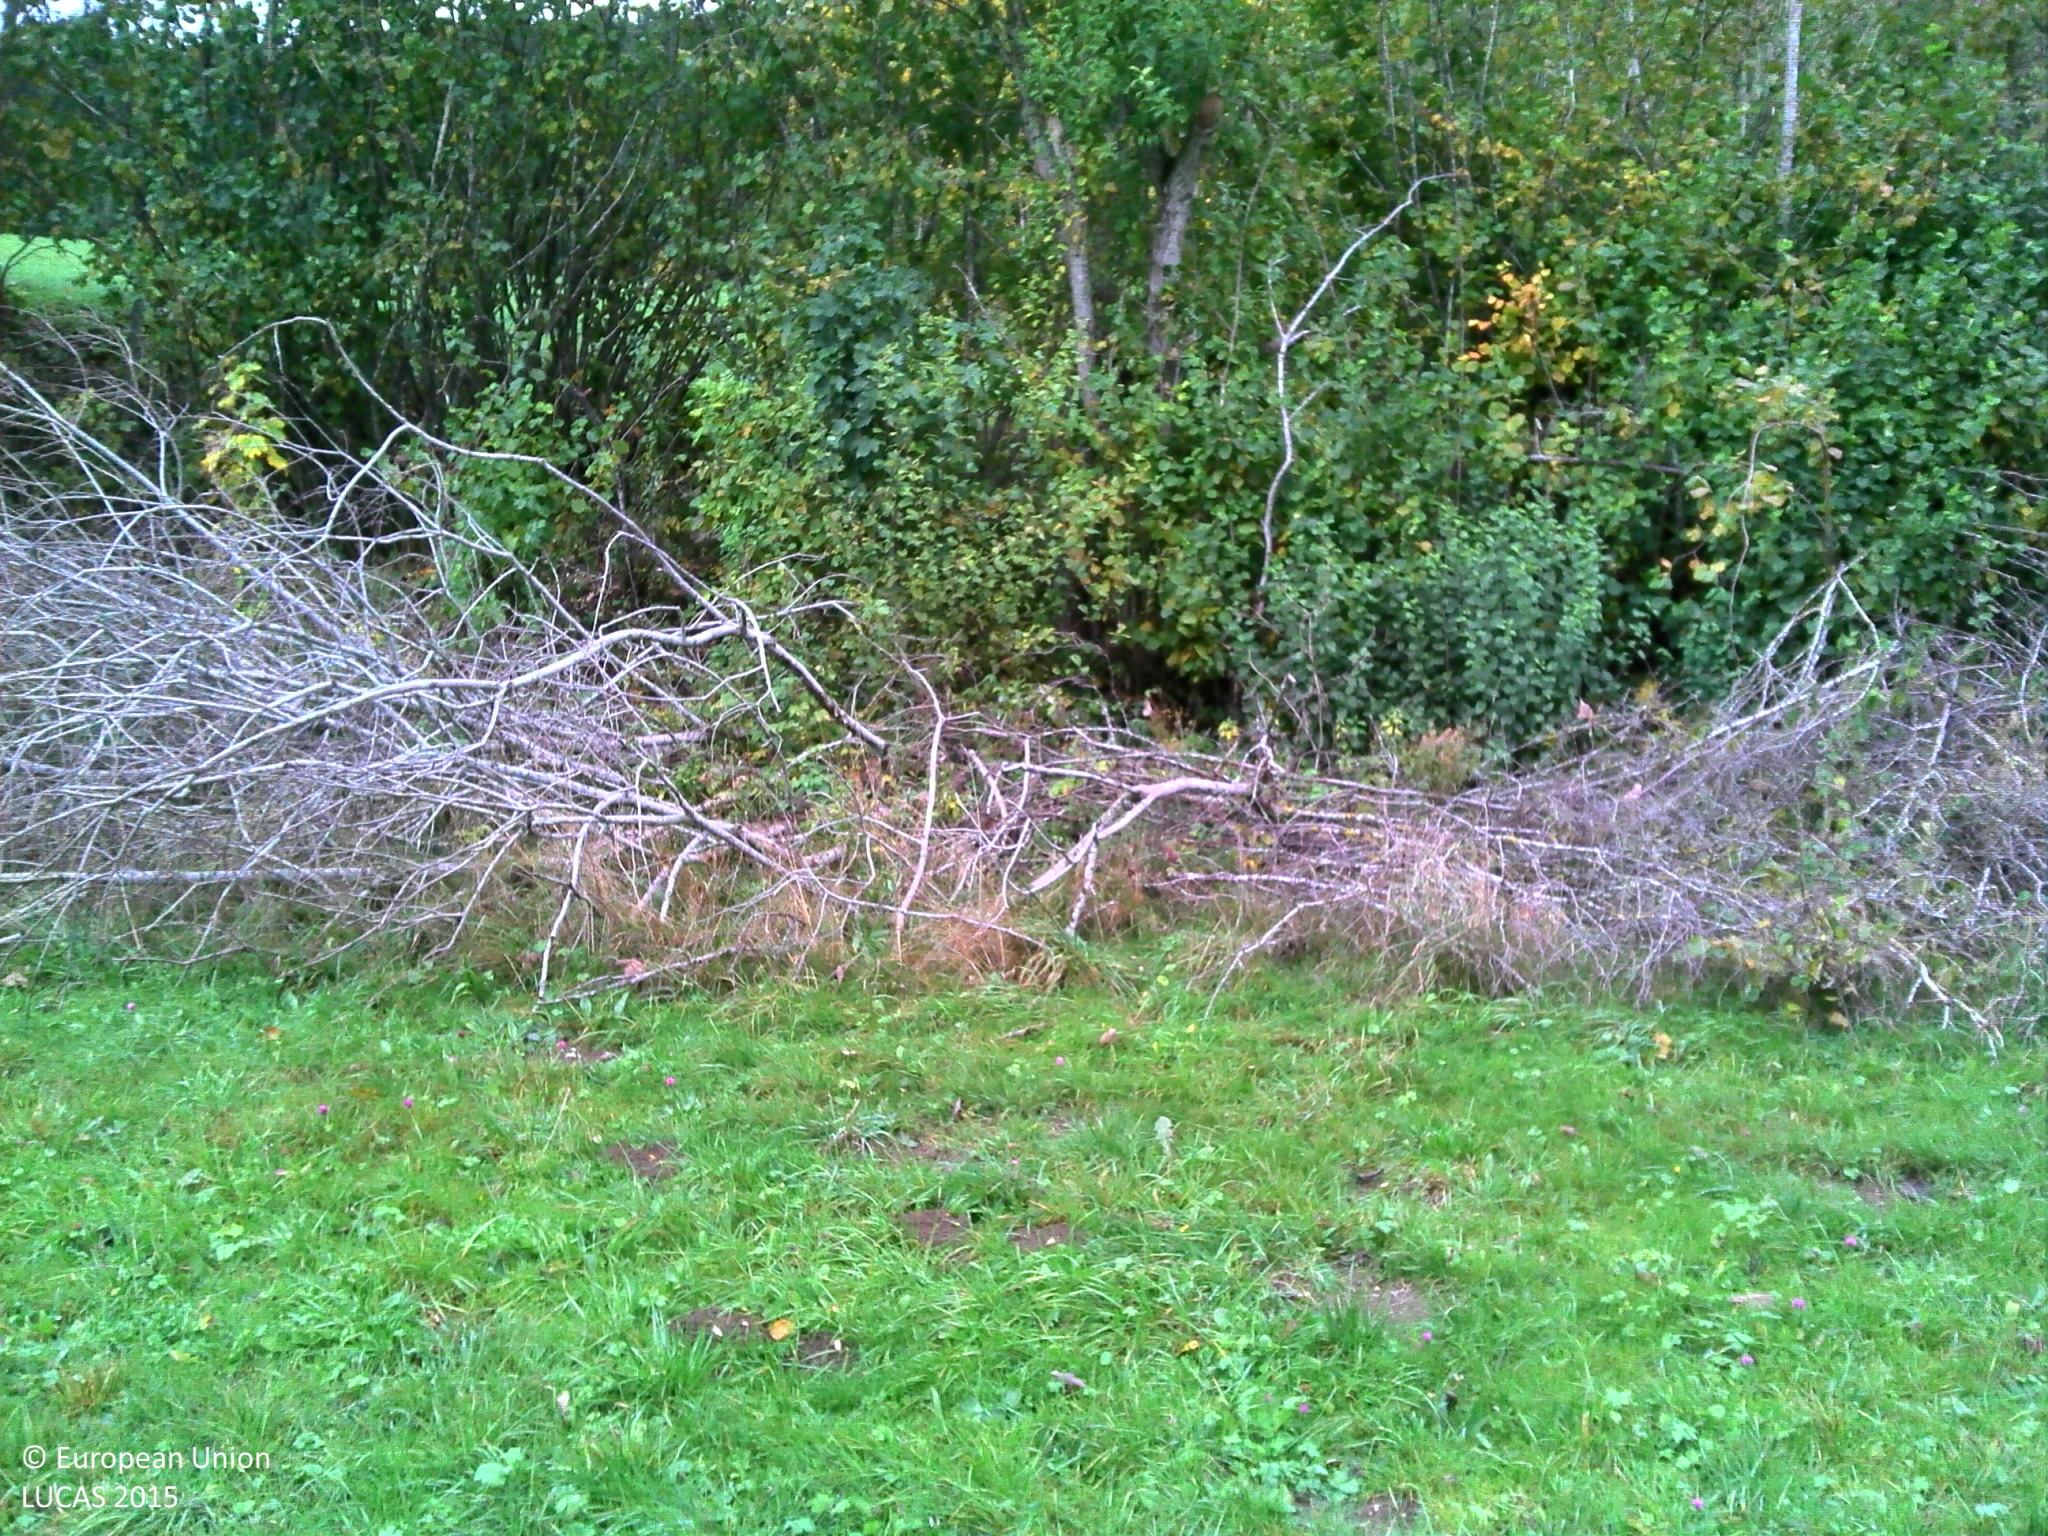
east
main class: Grassland
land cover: Grassland without tree/shrub cover
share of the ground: > 75 %
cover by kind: herbaceous plants 100 %
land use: Agriculture (excluding fallow land and kitchen gardens)
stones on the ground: < 10 %
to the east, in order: Grassland without tree/shrub cover; Broadleaved woodland; Grassland without tree/shrub cover; Broadleaved woodland; Grassland without tree/shrub cover; Spruce dominated coniferous woodland; Tracks; Spruce dominated coniferous woodland; Grass margins; Paved roads, cycling and walking lanes; Grass margins; Spruce dominated coniferous woodland; Spruce dominated mixed woodland
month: October
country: FR
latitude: 46.7945
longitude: 6.3736
